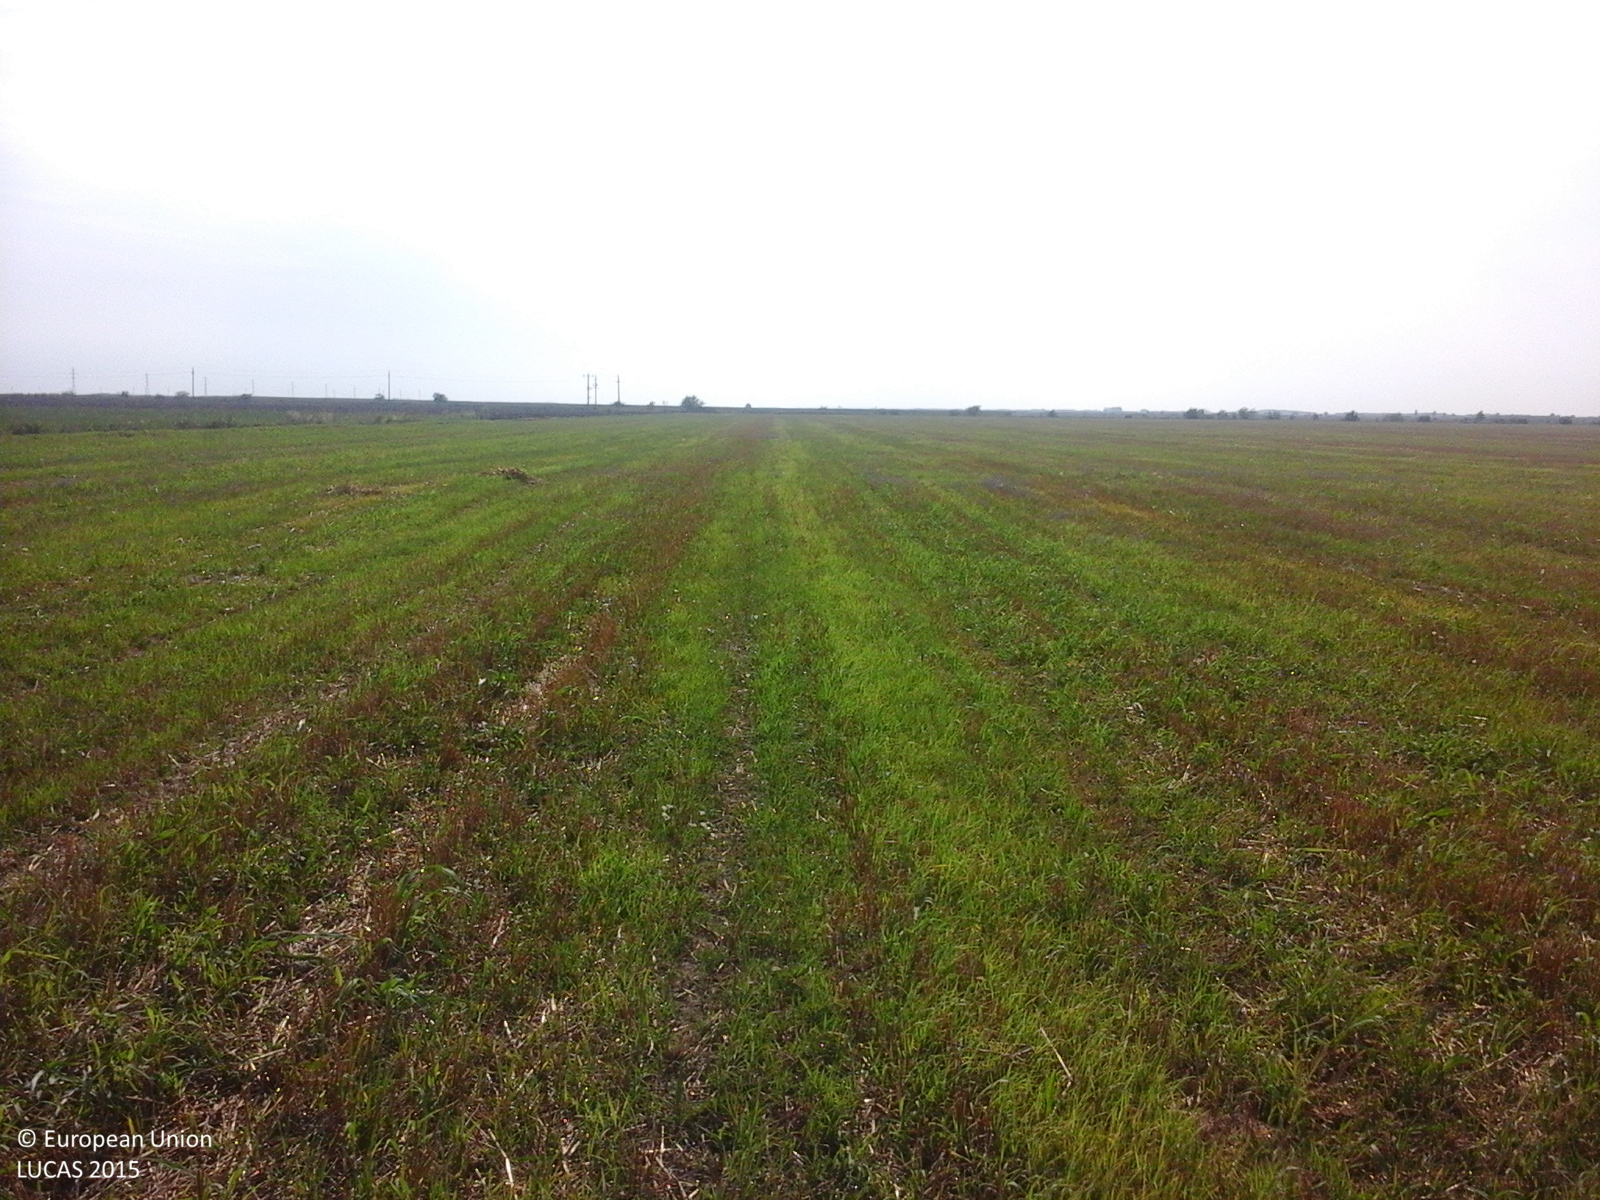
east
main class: Cropland
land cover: Barley
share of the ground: < 10 %
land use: Agriculture (excluding fallow land and kitchen gardens)
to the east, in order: Barley
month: July
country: RO
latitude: 44.6180
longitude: 27.4977
